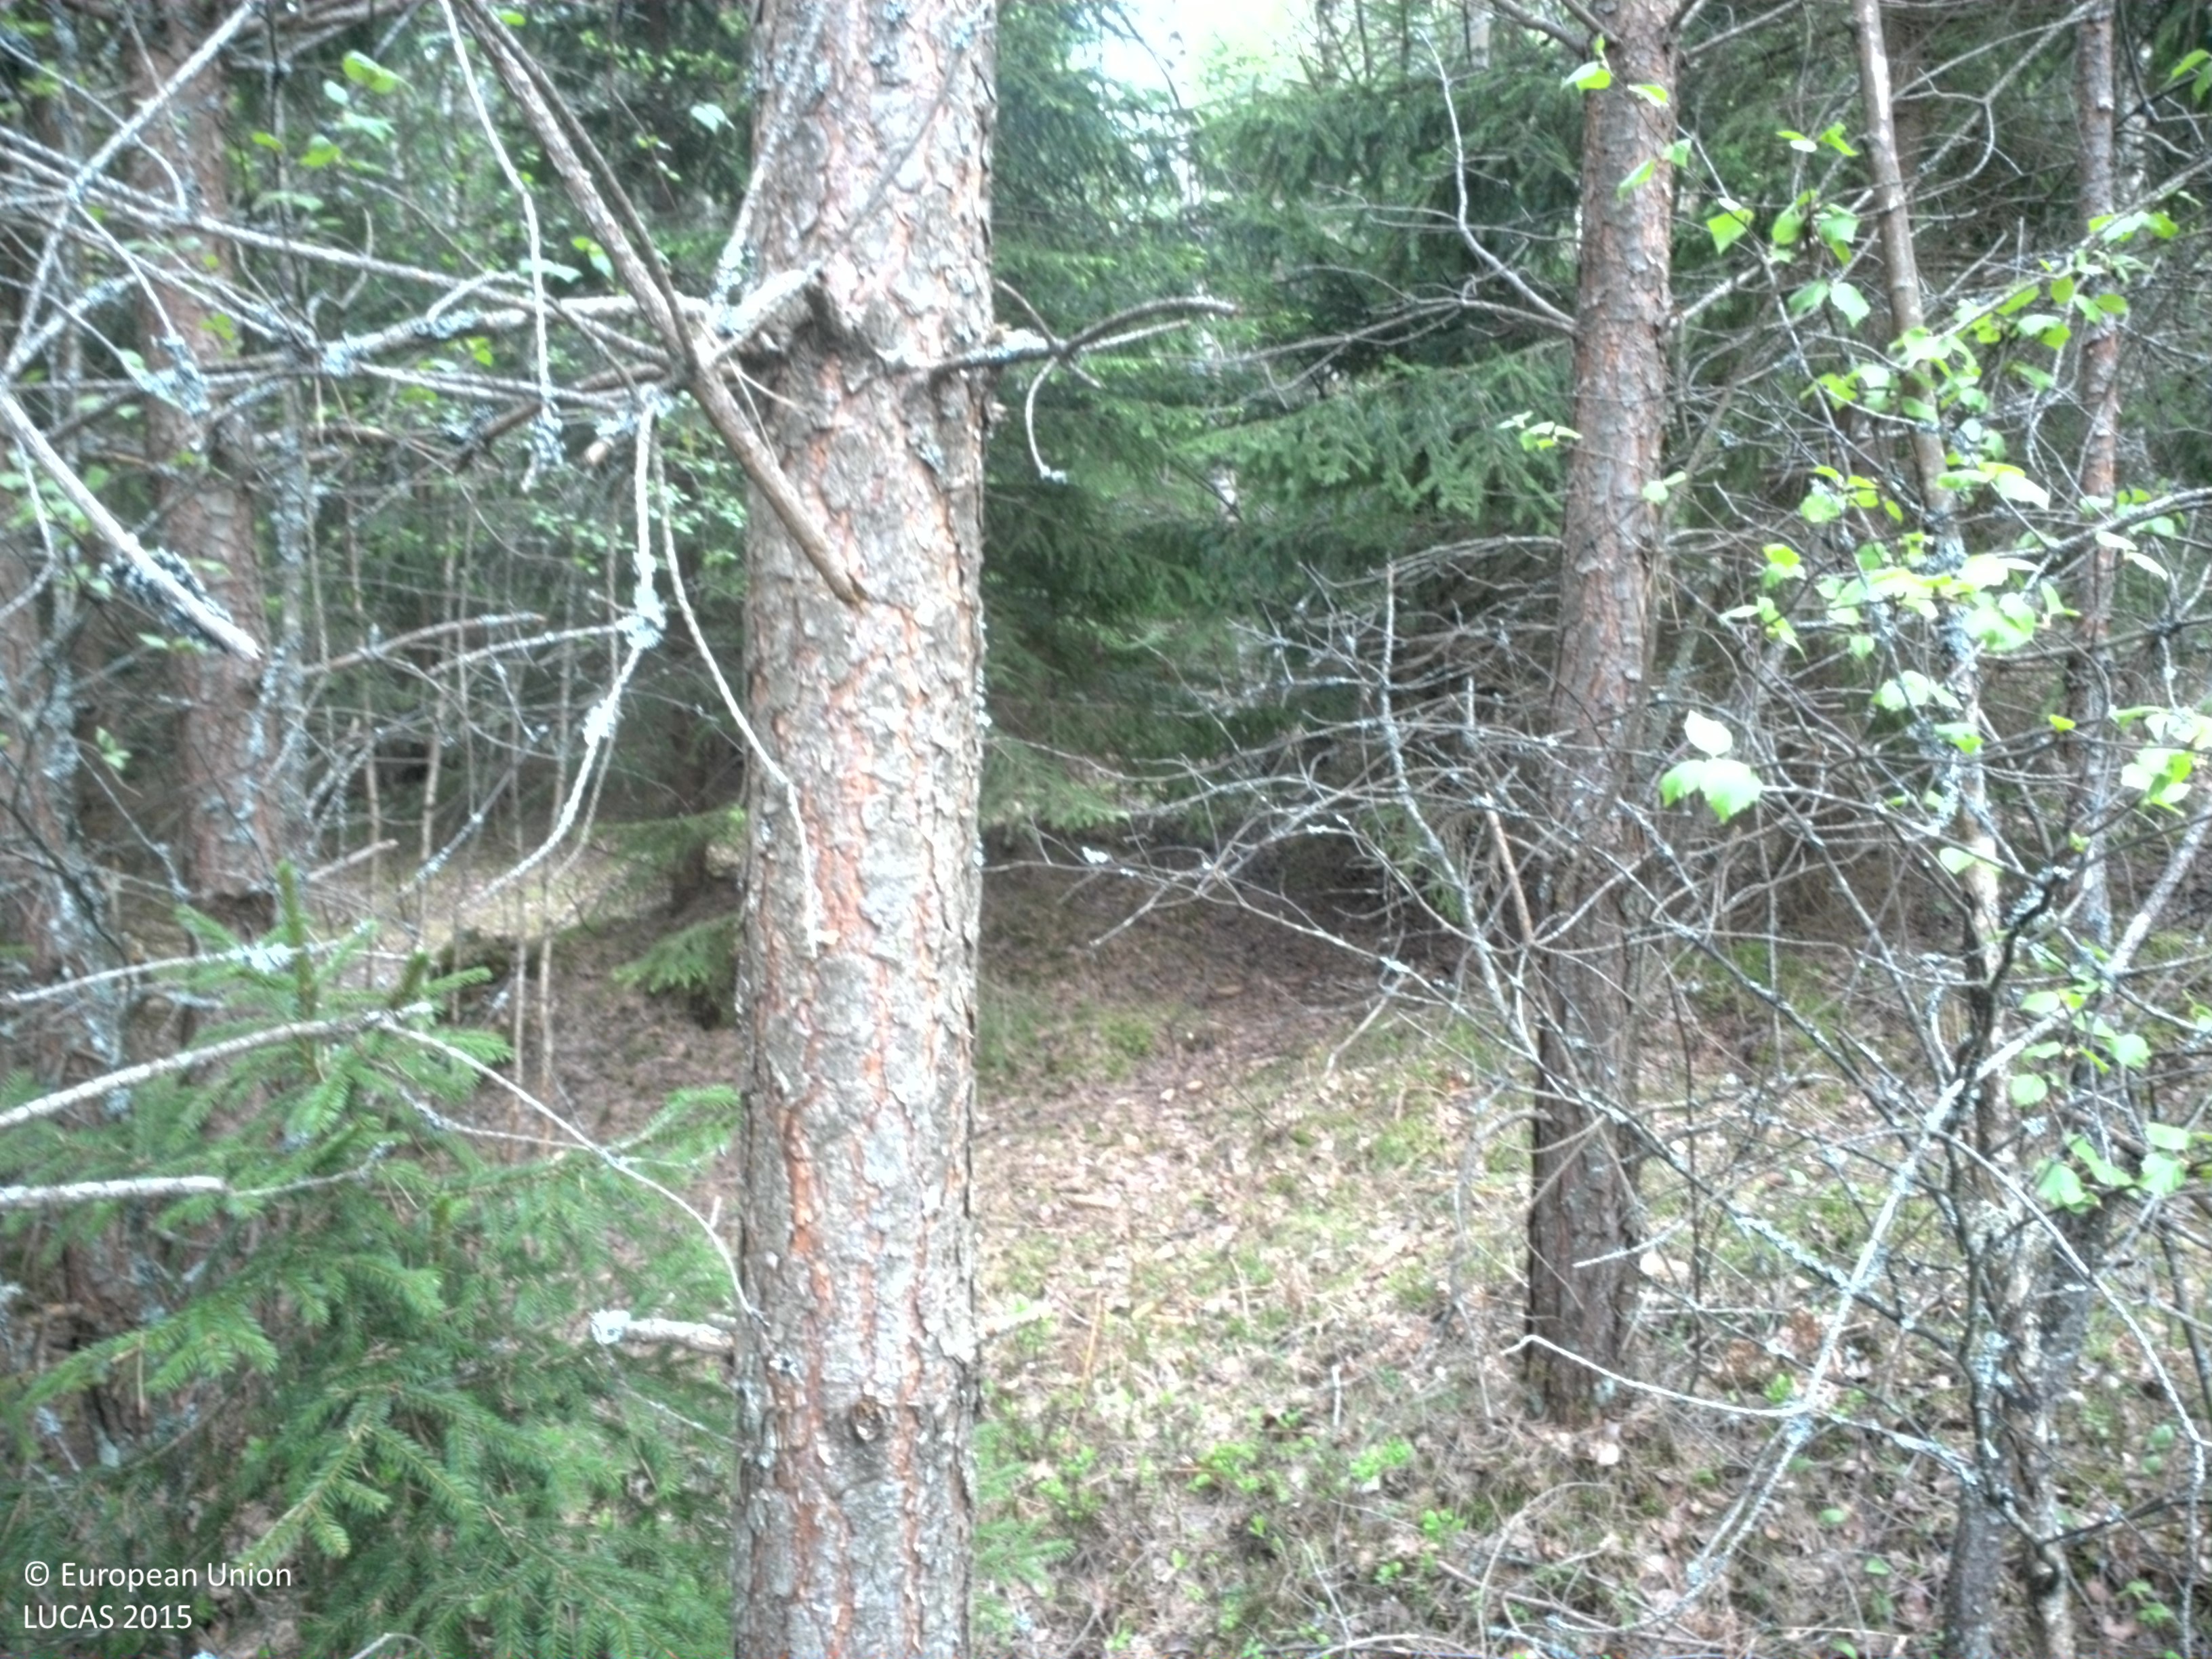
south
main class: Woodland
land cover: Pine dominated coniferous woodland
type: boreal forest
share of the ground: 50 - 75 %
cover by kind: coniferous forest trees 65 %, shrubs 20 %, broadleaved forest trees 10 %, lichens and mosses 5 %
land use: Forestry
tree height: > 5 m
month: May
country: SE
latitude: 56.6205
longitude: 15.2623
